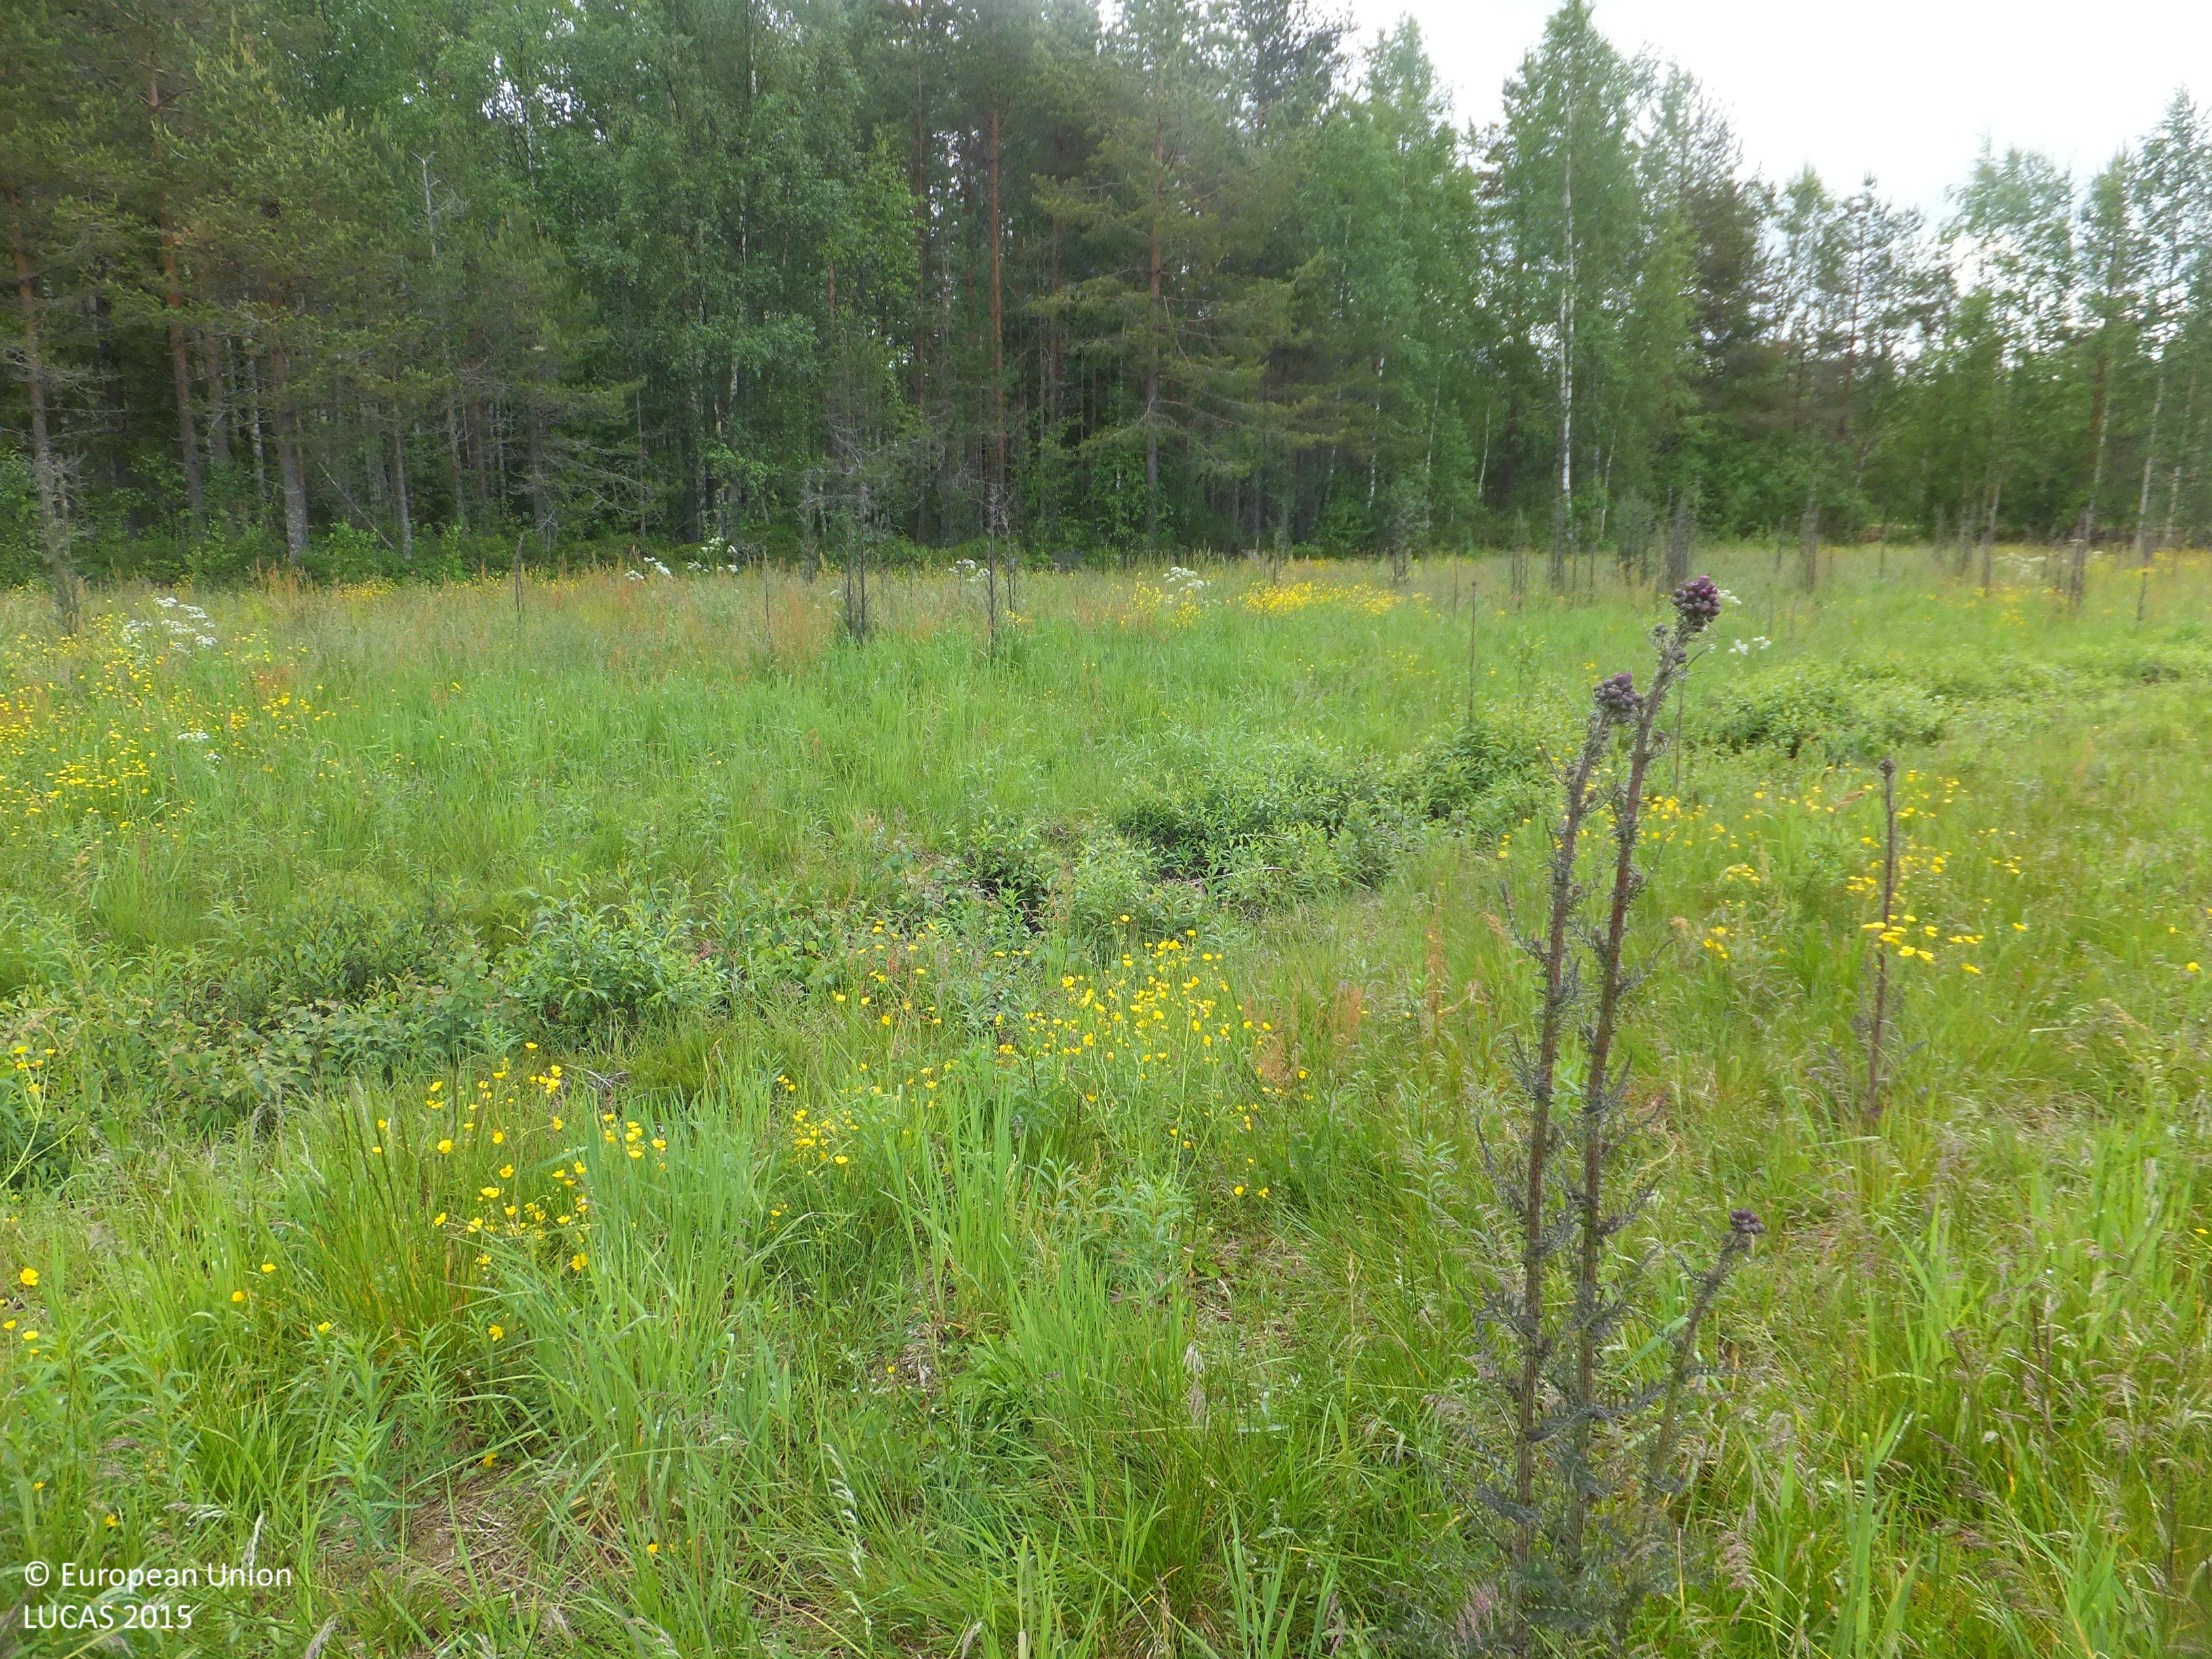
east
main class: Grassland
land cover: Grassland without tree/shrub cover
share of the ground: > 75 %
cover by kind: herbaceous plants 95 %, consolidated bare surface 5 %
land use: Agriculture (excluding fallow land and kitchen gardens)
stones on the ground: < 10 %
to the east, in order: Grassland without tree/shrub cover; Ditches and canals; Abandoned hedges; Grassland without tree/shrub cover; Ditches and canals; Other mixed woodland; Ditches and canals; Other mixed woodland; Broadleaved woodland; Ditches and canals; Grass margins; Paved roads, cycling and walking lanes; Grass margins; Ditches and canals; Shrubland without tree cover; Pine dominated mixed woodland; Tracks; Pine dominated mixed woodland
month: June
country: FI
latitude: 63.3609
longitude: 24.0870
